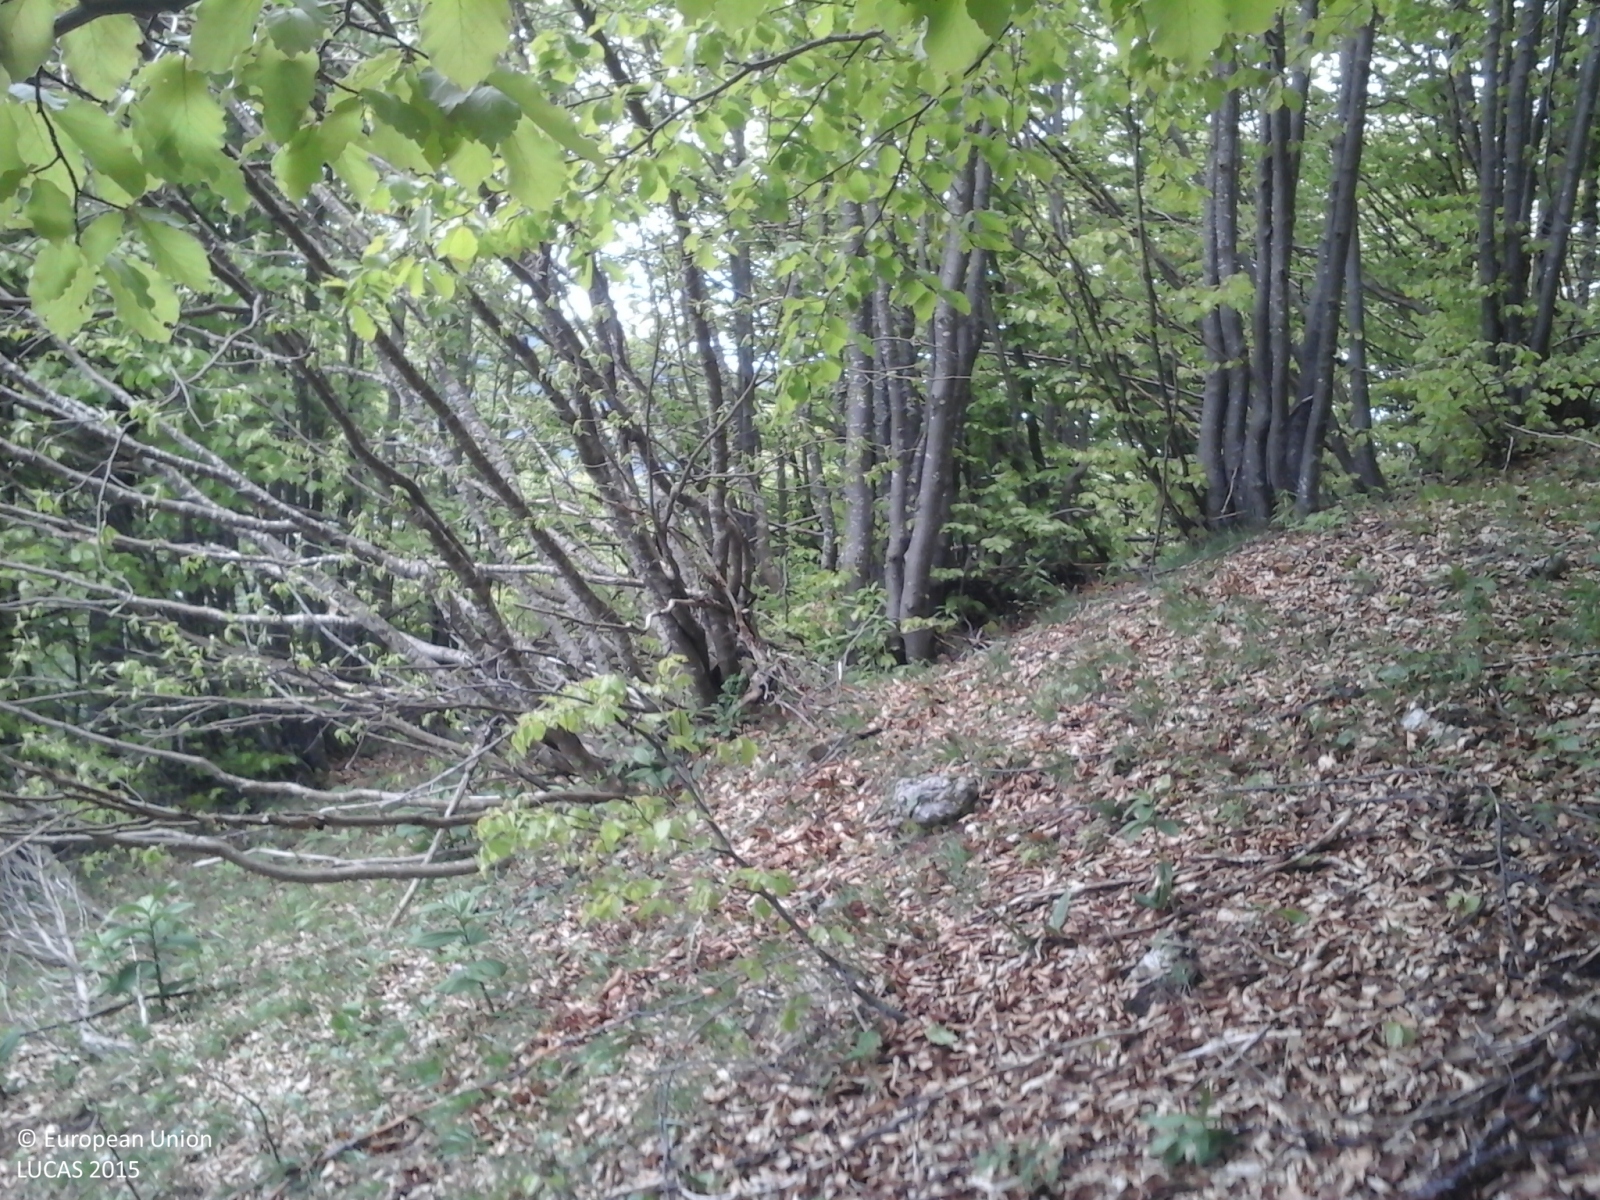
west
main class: Woodland
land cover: Broadleaved woodland
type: mountainous beech forest
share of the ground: > 75 %
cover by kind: broadleaved forest trees 100 %
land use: Forestry
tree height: > 5 m
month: May
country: IT
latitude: 45.7322
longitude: 11.1676
